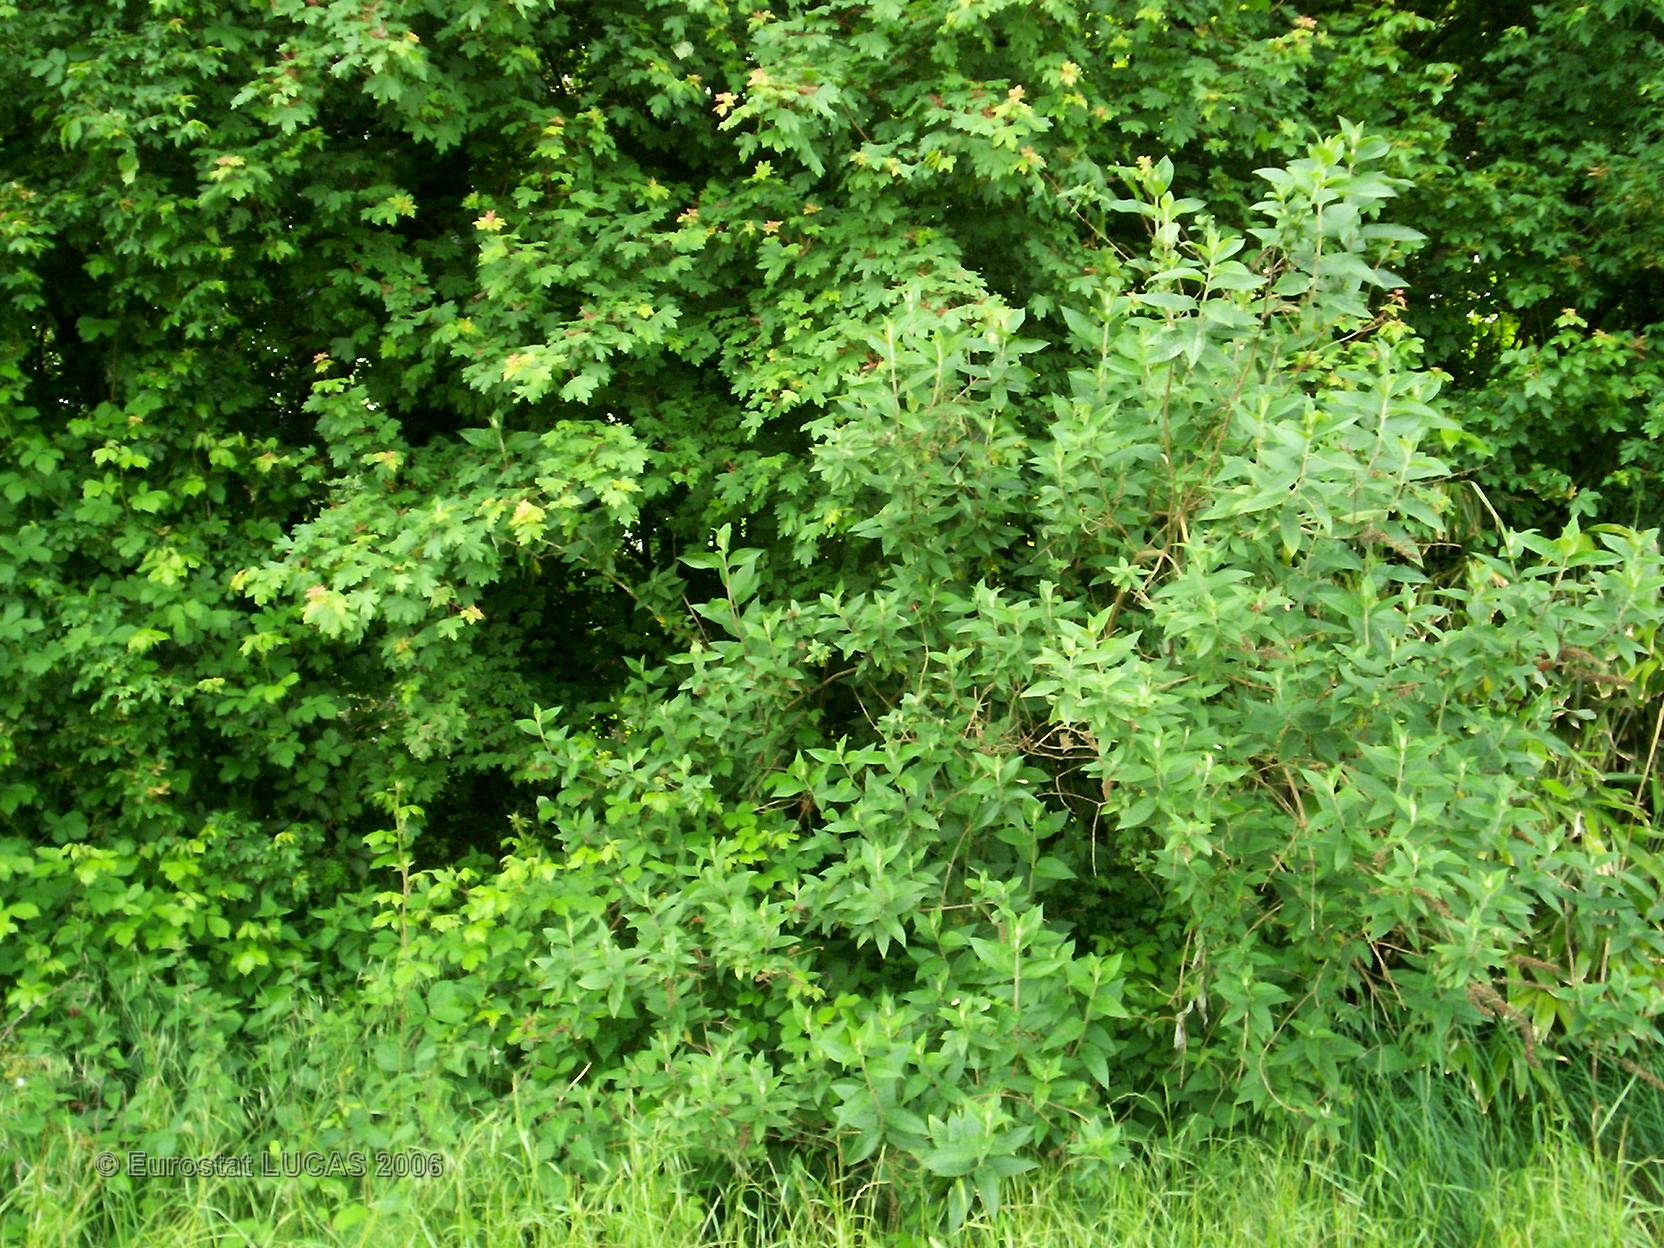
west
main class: Grassland
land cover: Grassland without tree/shrub cover
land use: Agriculture (excluding fallow land and kitchen gardens)
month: May
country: FR
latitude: 47.9145
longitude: -3.5240
